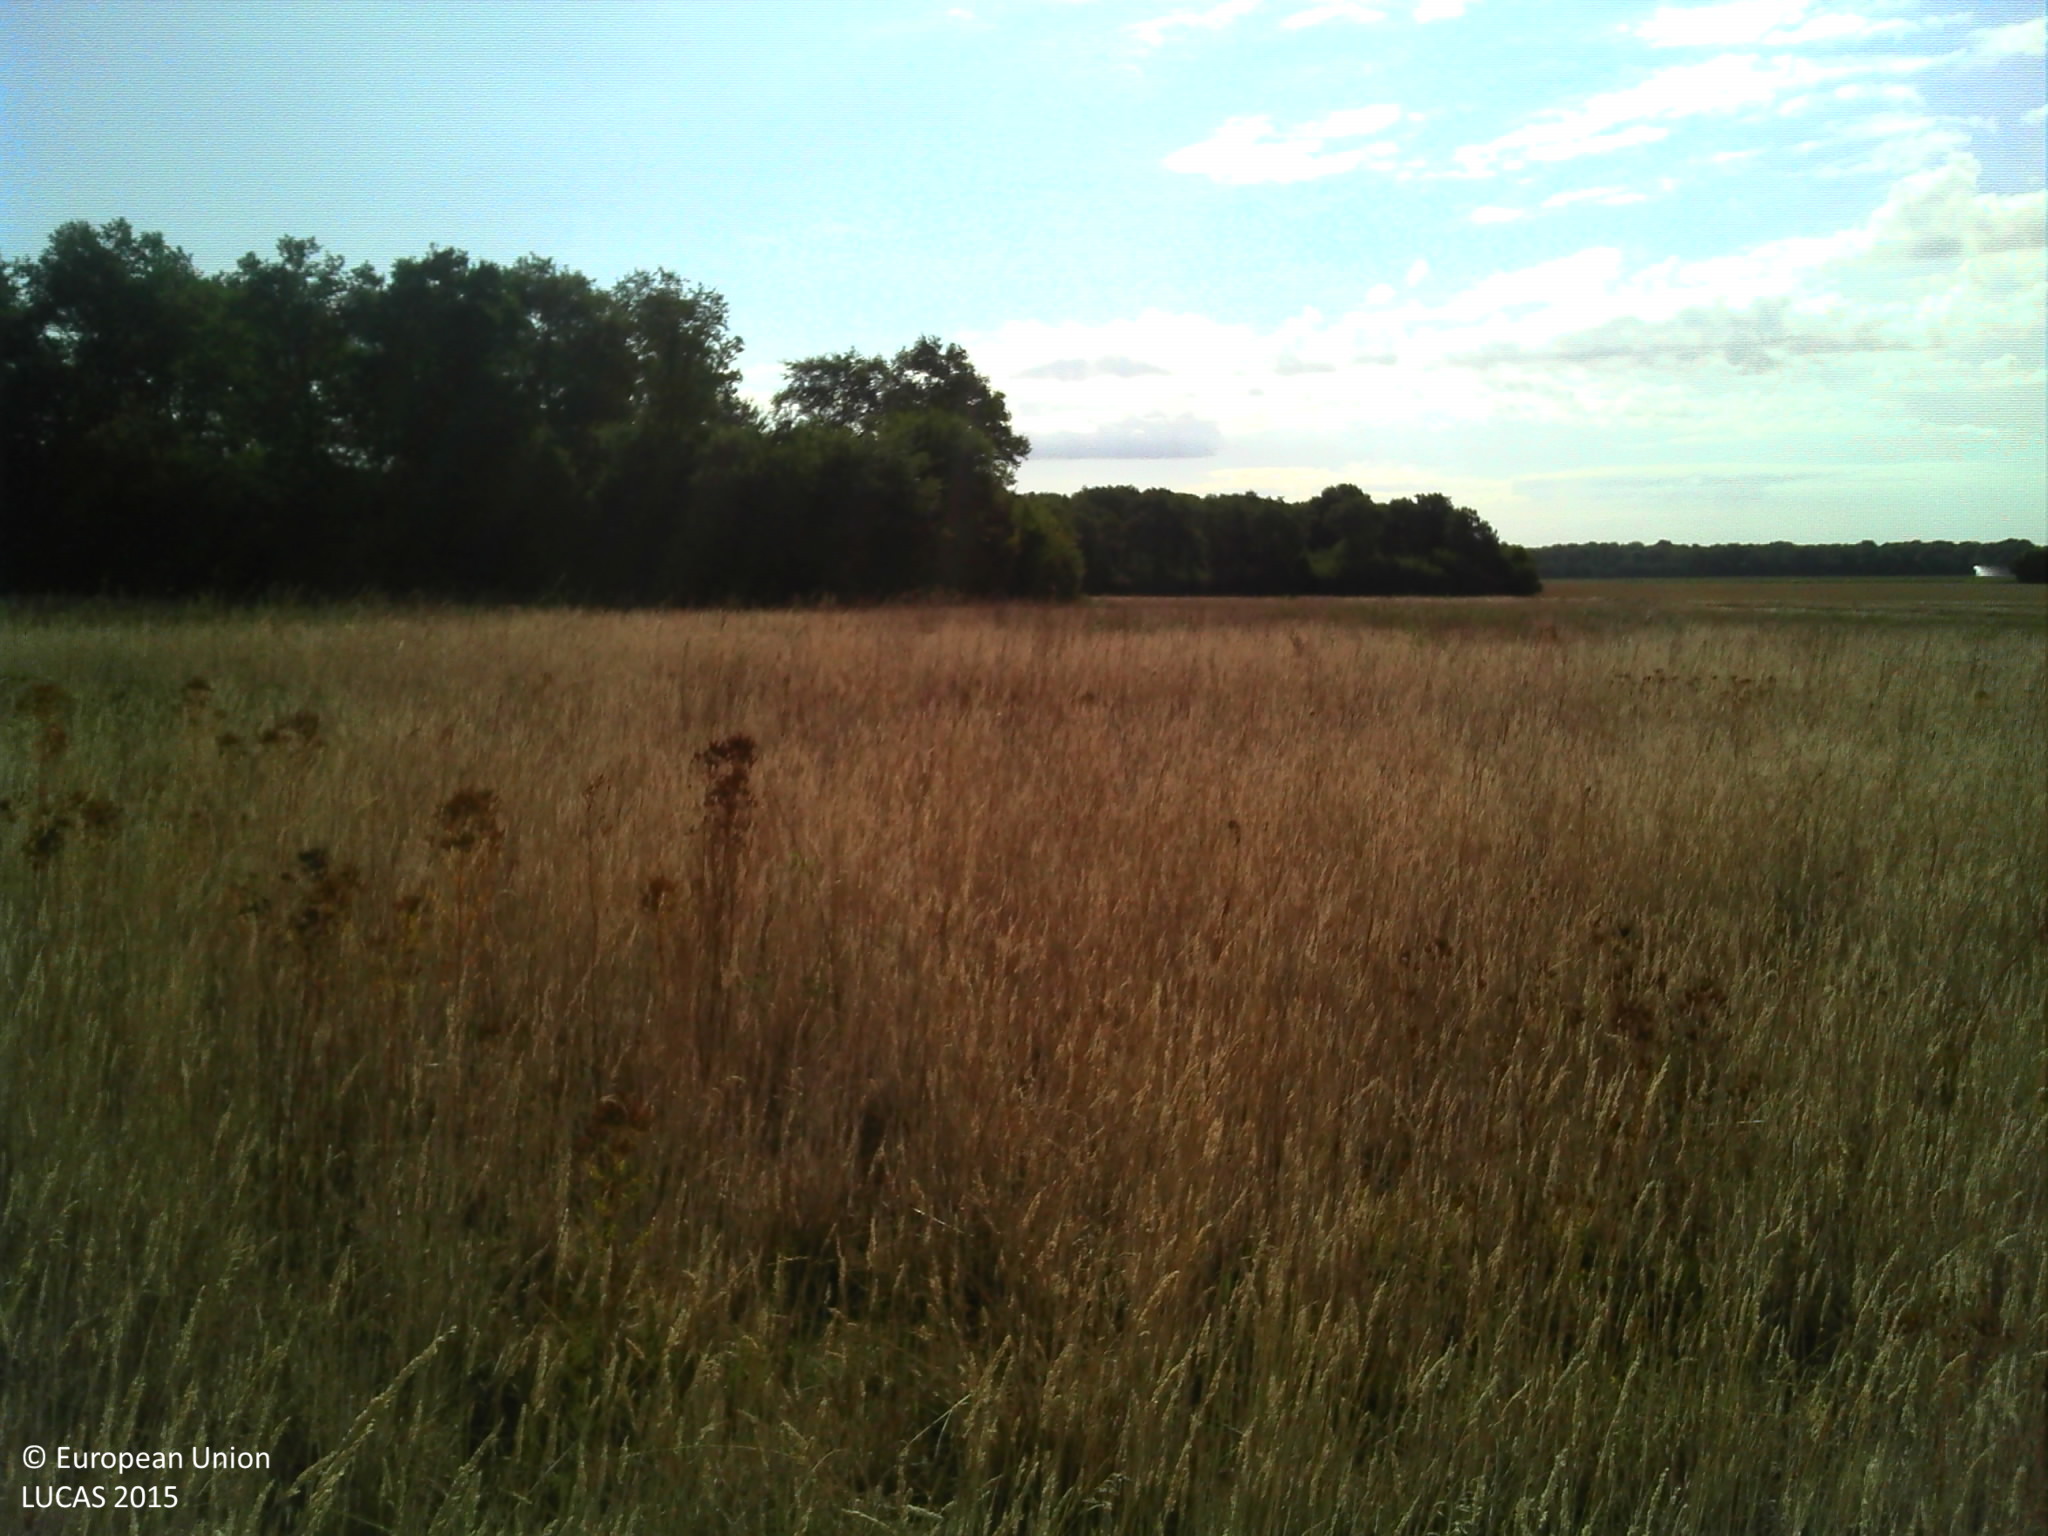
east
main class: Grassland
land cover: Grassland without tree/shrub cover
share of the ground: > 75 %
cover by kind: herbaceous plants 100 %
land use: Agriculture (excluding fallow land and kitchen gardens)
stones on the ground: 10 - 25 %
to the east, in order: Grassland without tree/shrub cover; Broadleaved woodland; Common wheat
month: July
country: FR
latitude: 47.0739
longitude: 2.1293
